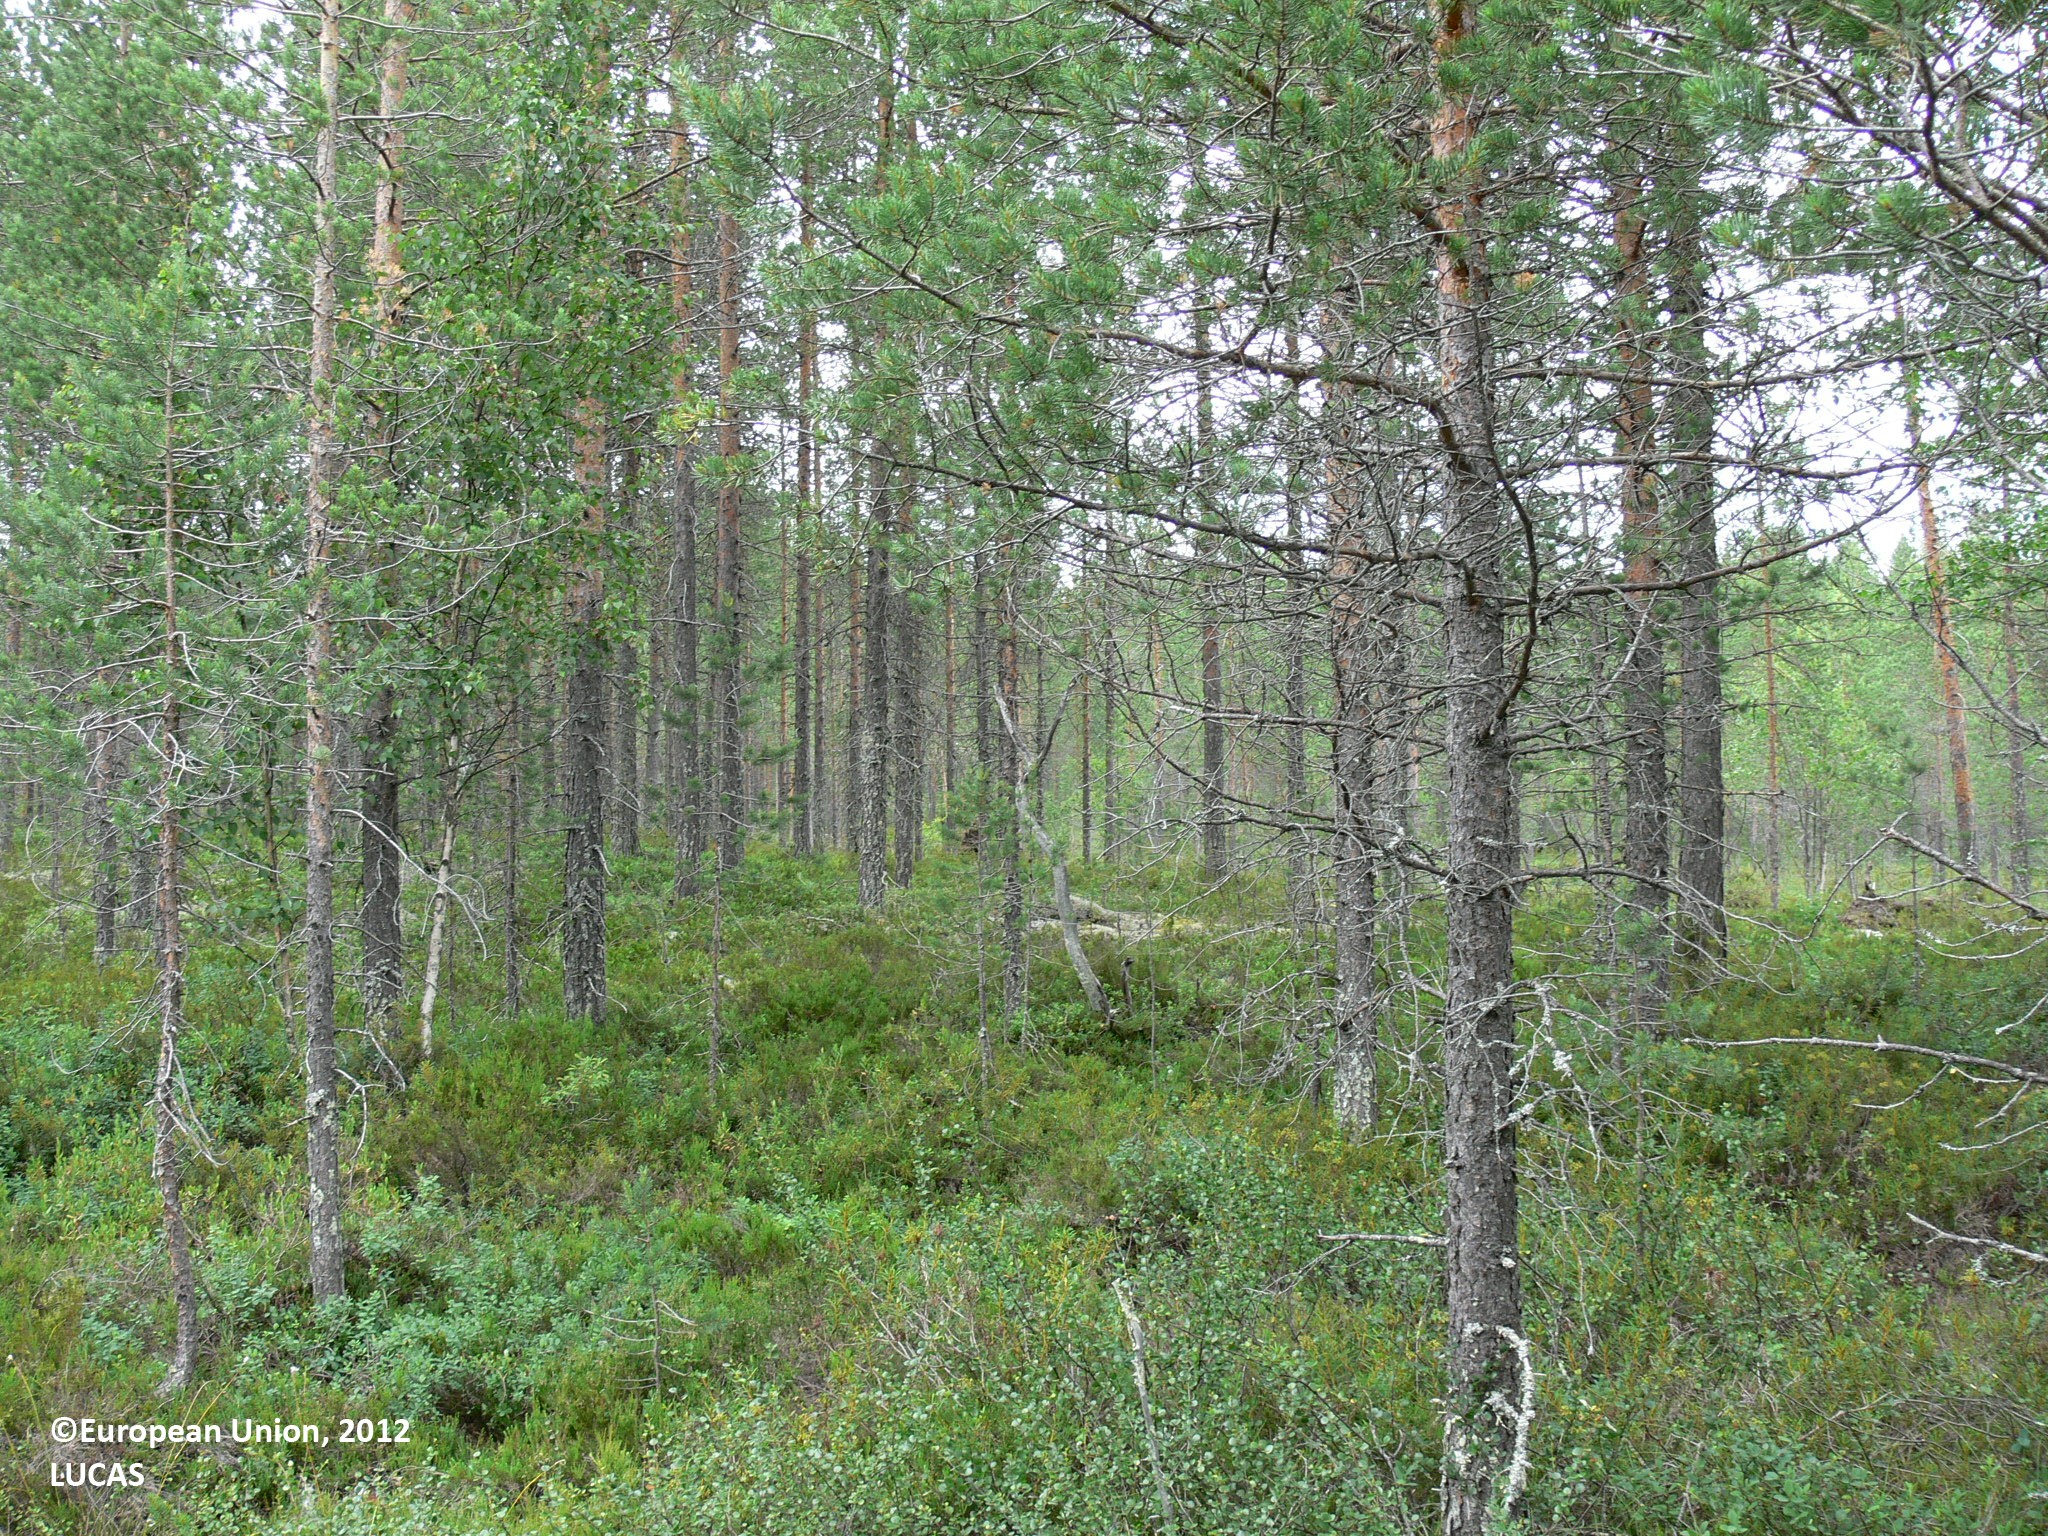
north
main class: Woodland
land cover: Pine dominated mixed woodland
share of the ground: 50 - 75 %
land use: Forestry
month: July
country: FI
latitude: 63.1723
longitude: 30.7209
